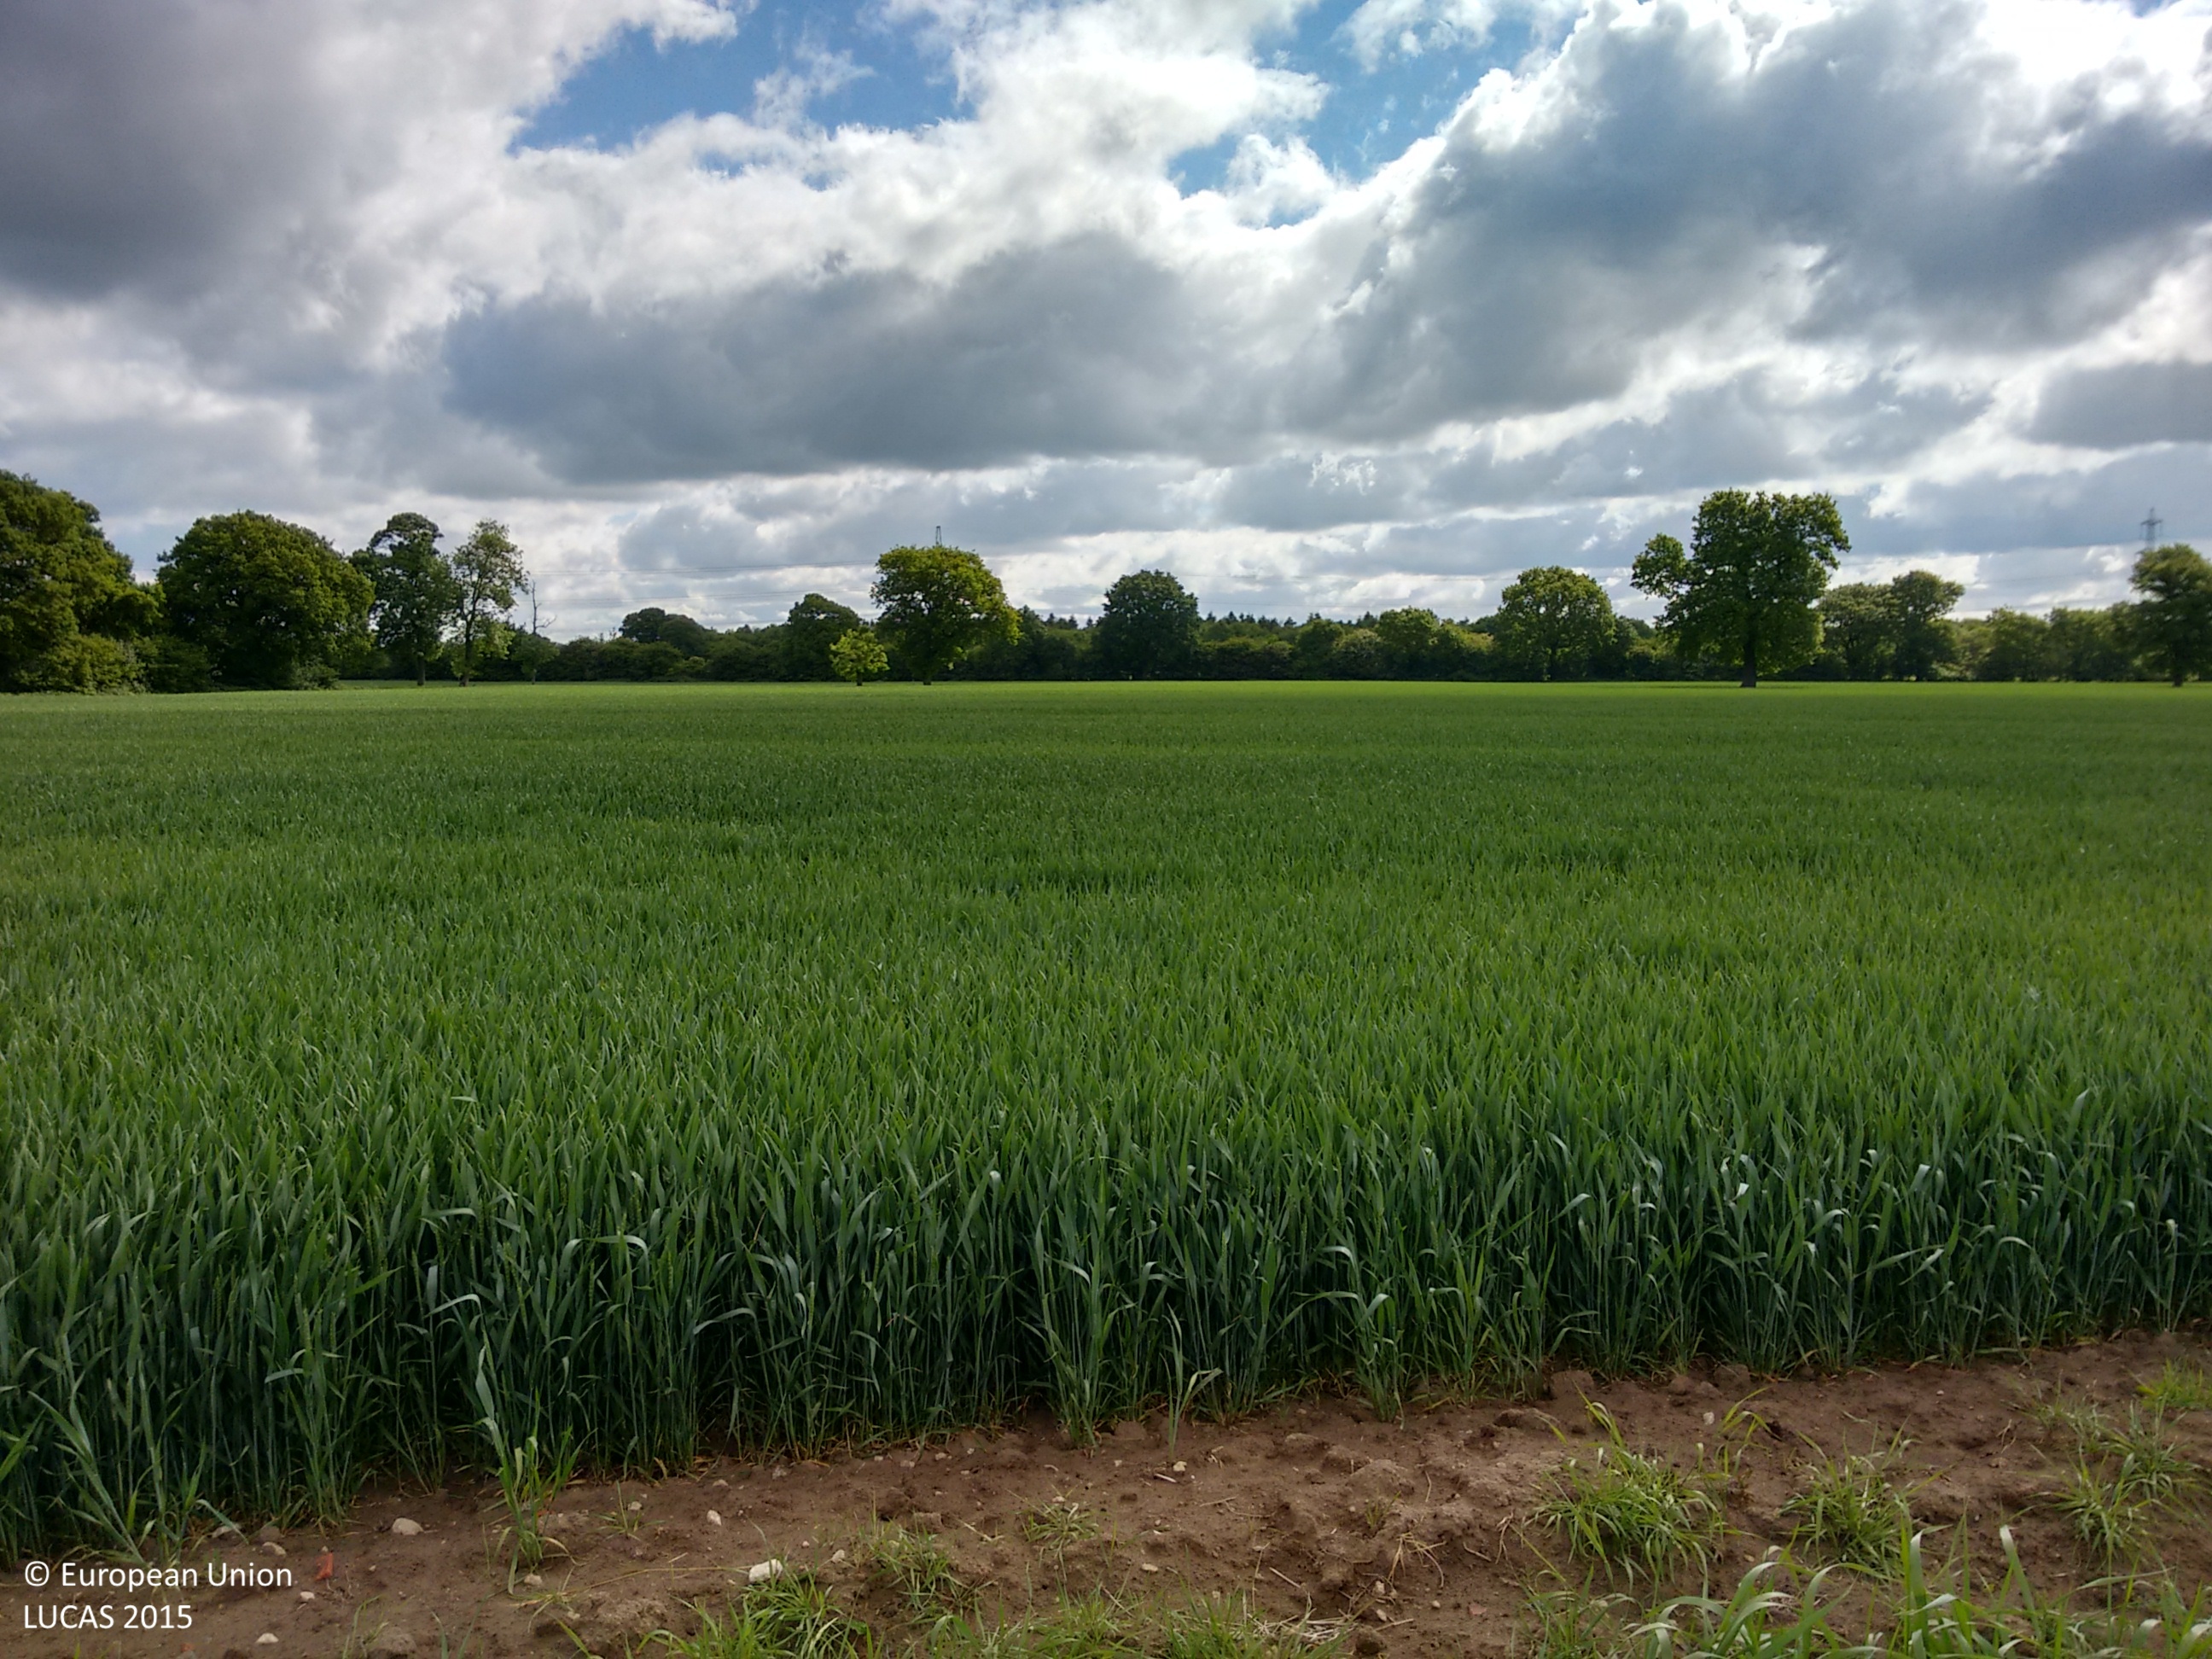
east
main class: Cropland
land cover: Common wheat
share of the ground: > 75 %
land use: Agriculture (excluding fallow land and kitchen gardens)
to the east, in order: Common wheat; Managed hedges; Arable land (only in case pi); Broadleaved woodland
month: June
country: GB
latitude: 54.0652
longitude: -1.1528
